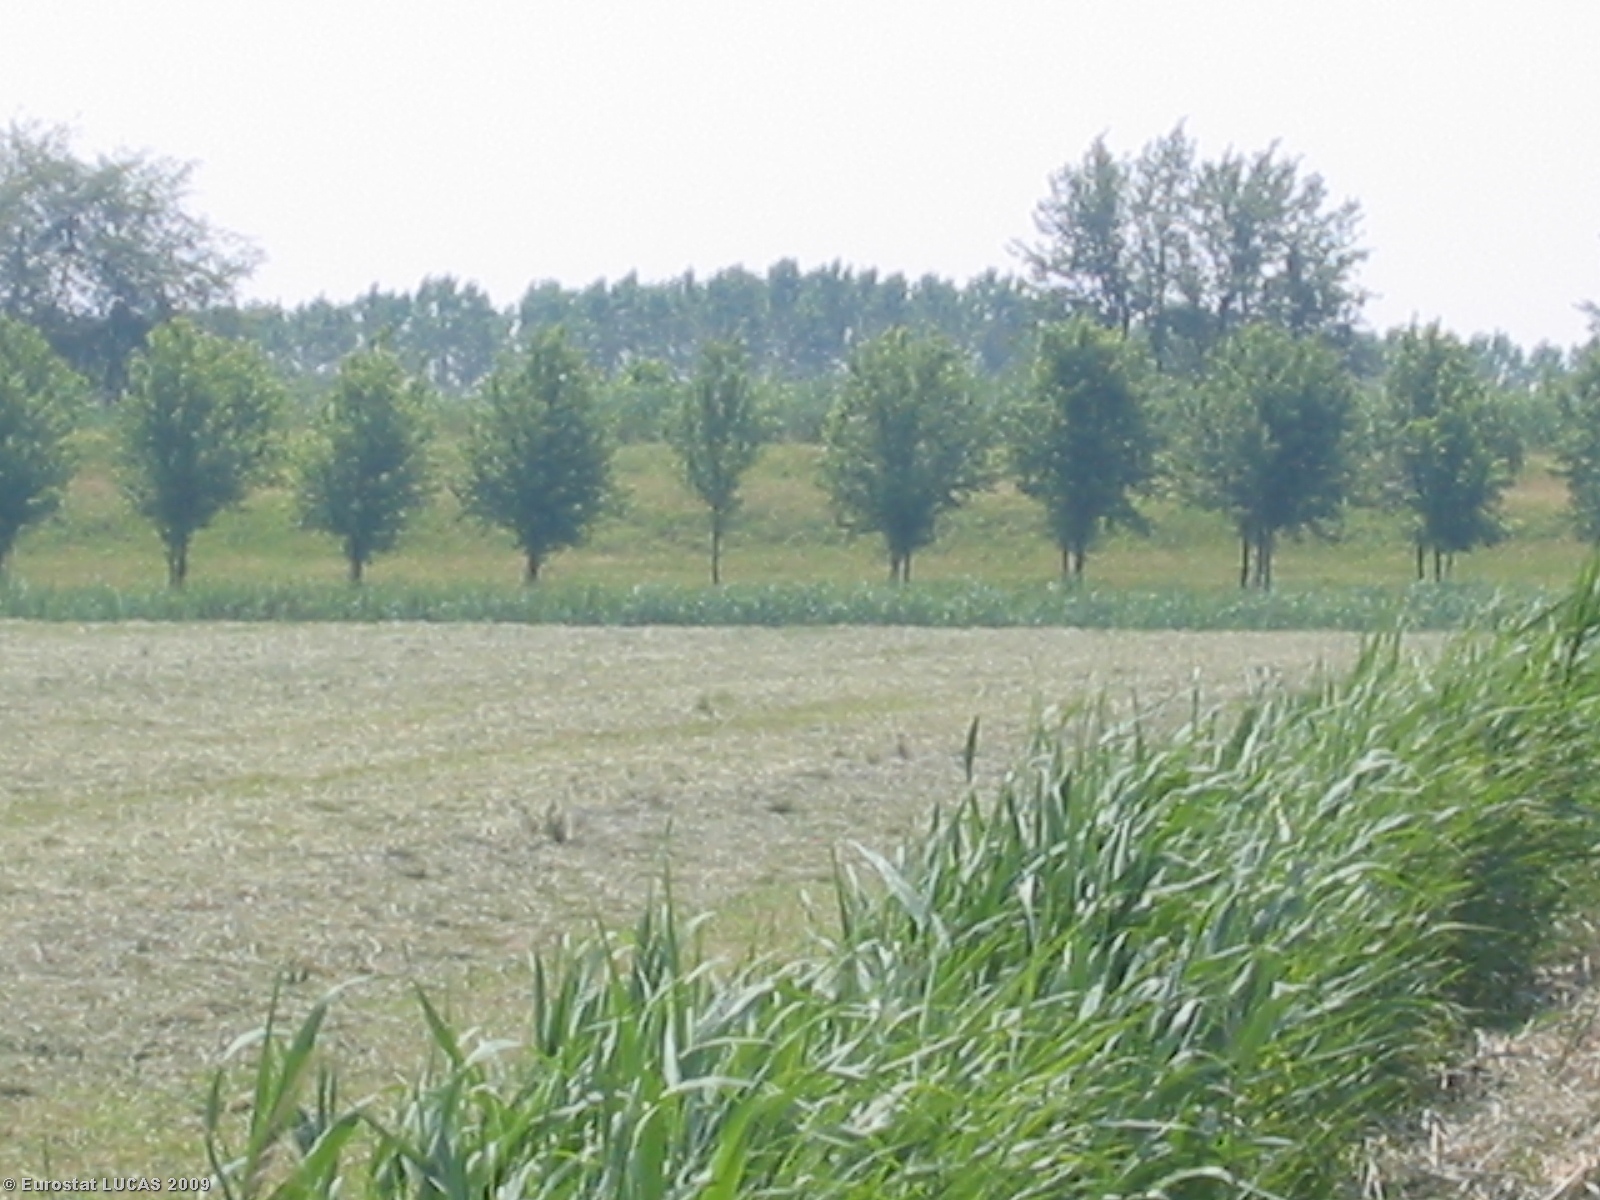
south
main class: Cropland
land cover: Lucerne
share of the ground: > 75 %
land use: Agriculture (excluding fallow land and kitchen gardens)
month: June
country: IT
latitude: 44.9067
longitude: 10.7710
